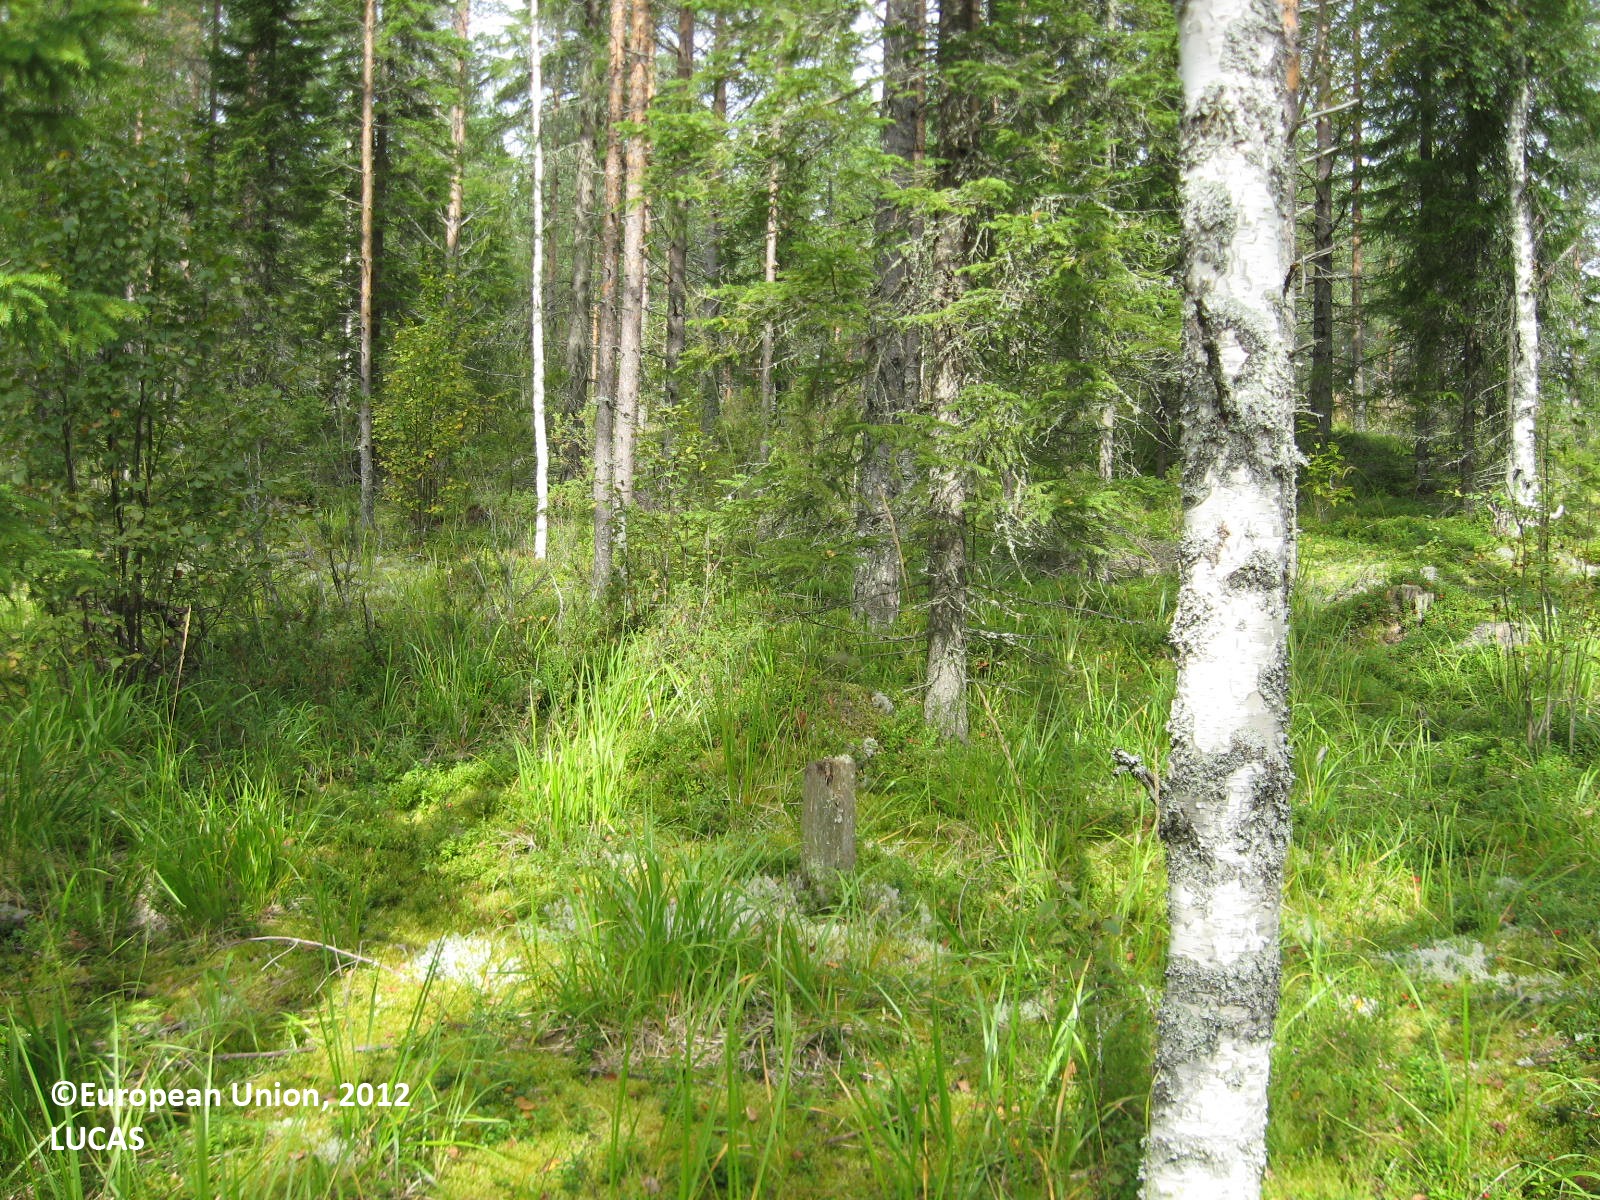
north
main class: Woodland
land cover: Pine dominated coniferous woodland
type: boreal forest
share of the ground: 50 - 75 %
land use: Forestry
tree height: > 5 m
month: August
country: FI
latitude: 63.7762
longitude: 29.1339
